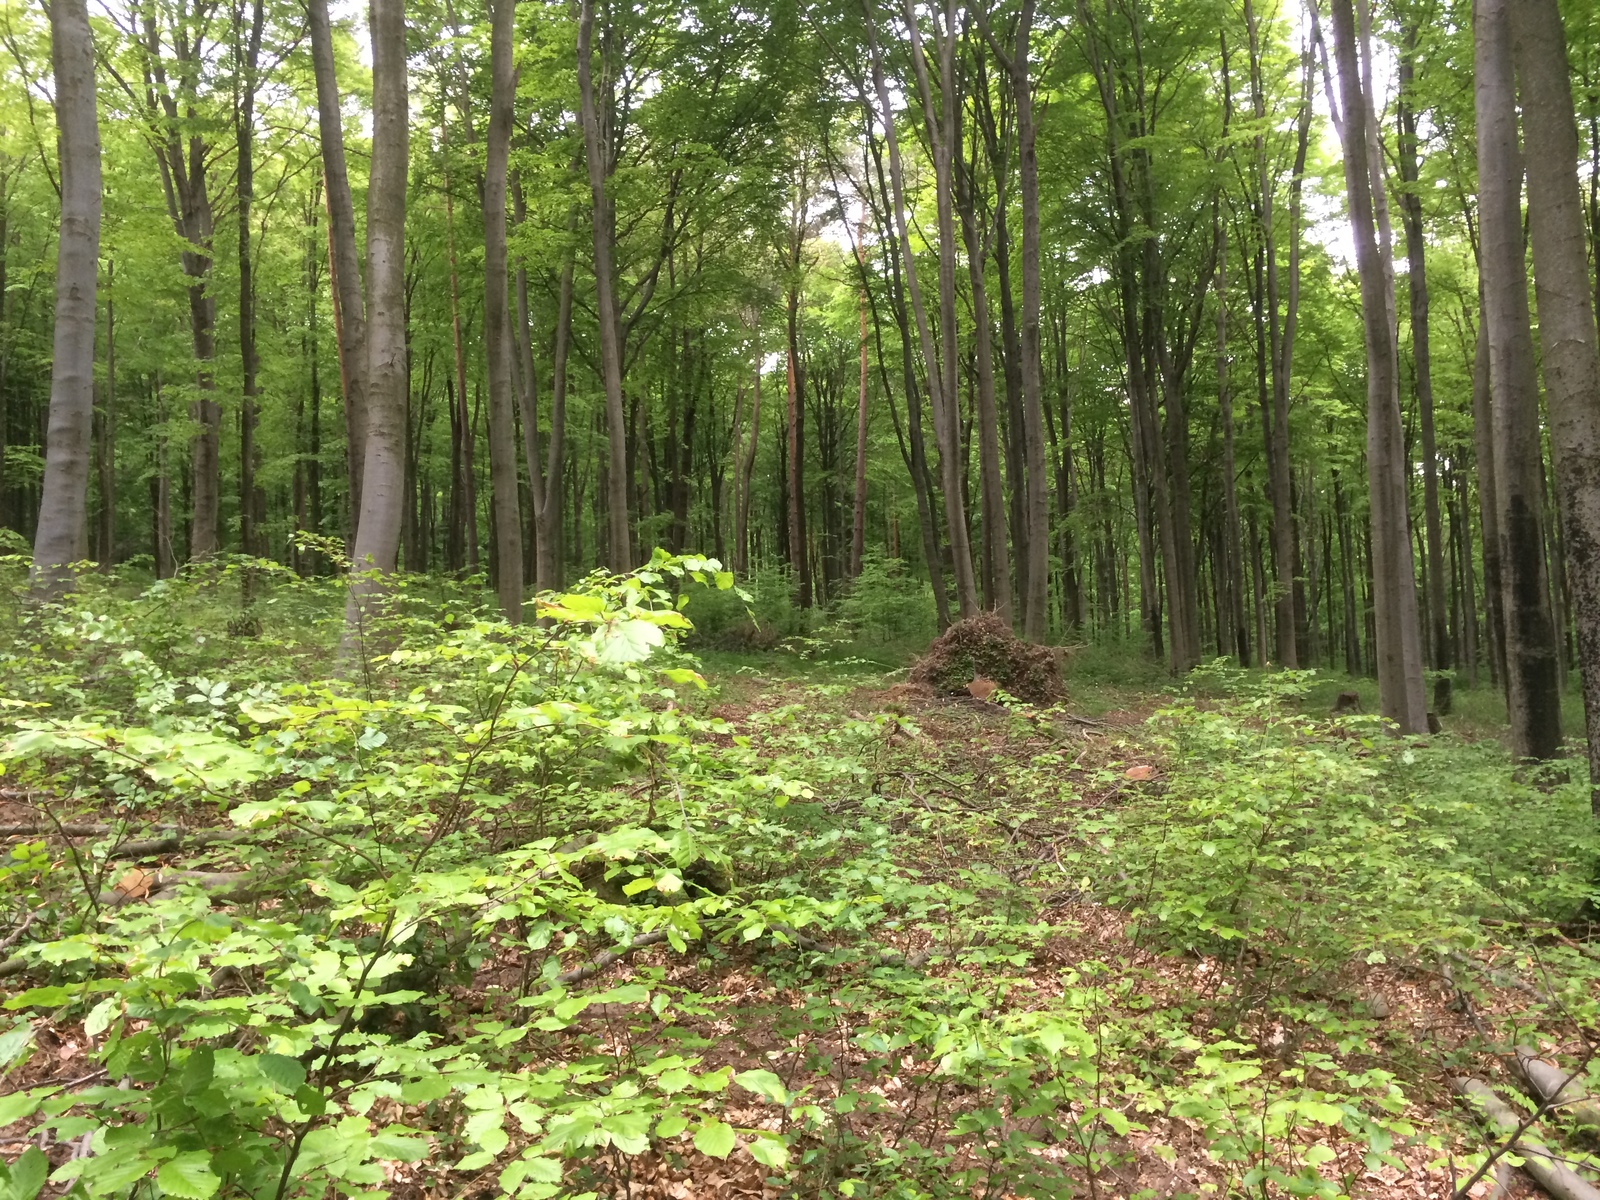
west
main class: Woodland
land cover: Broadleaved woodland
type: beech forest
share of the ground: > 75 %
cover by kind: broadleaved forest trees 100 %
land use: Forestry
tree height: > 5 m
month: May
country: AT
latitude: 48.0497
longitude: 16.1885
